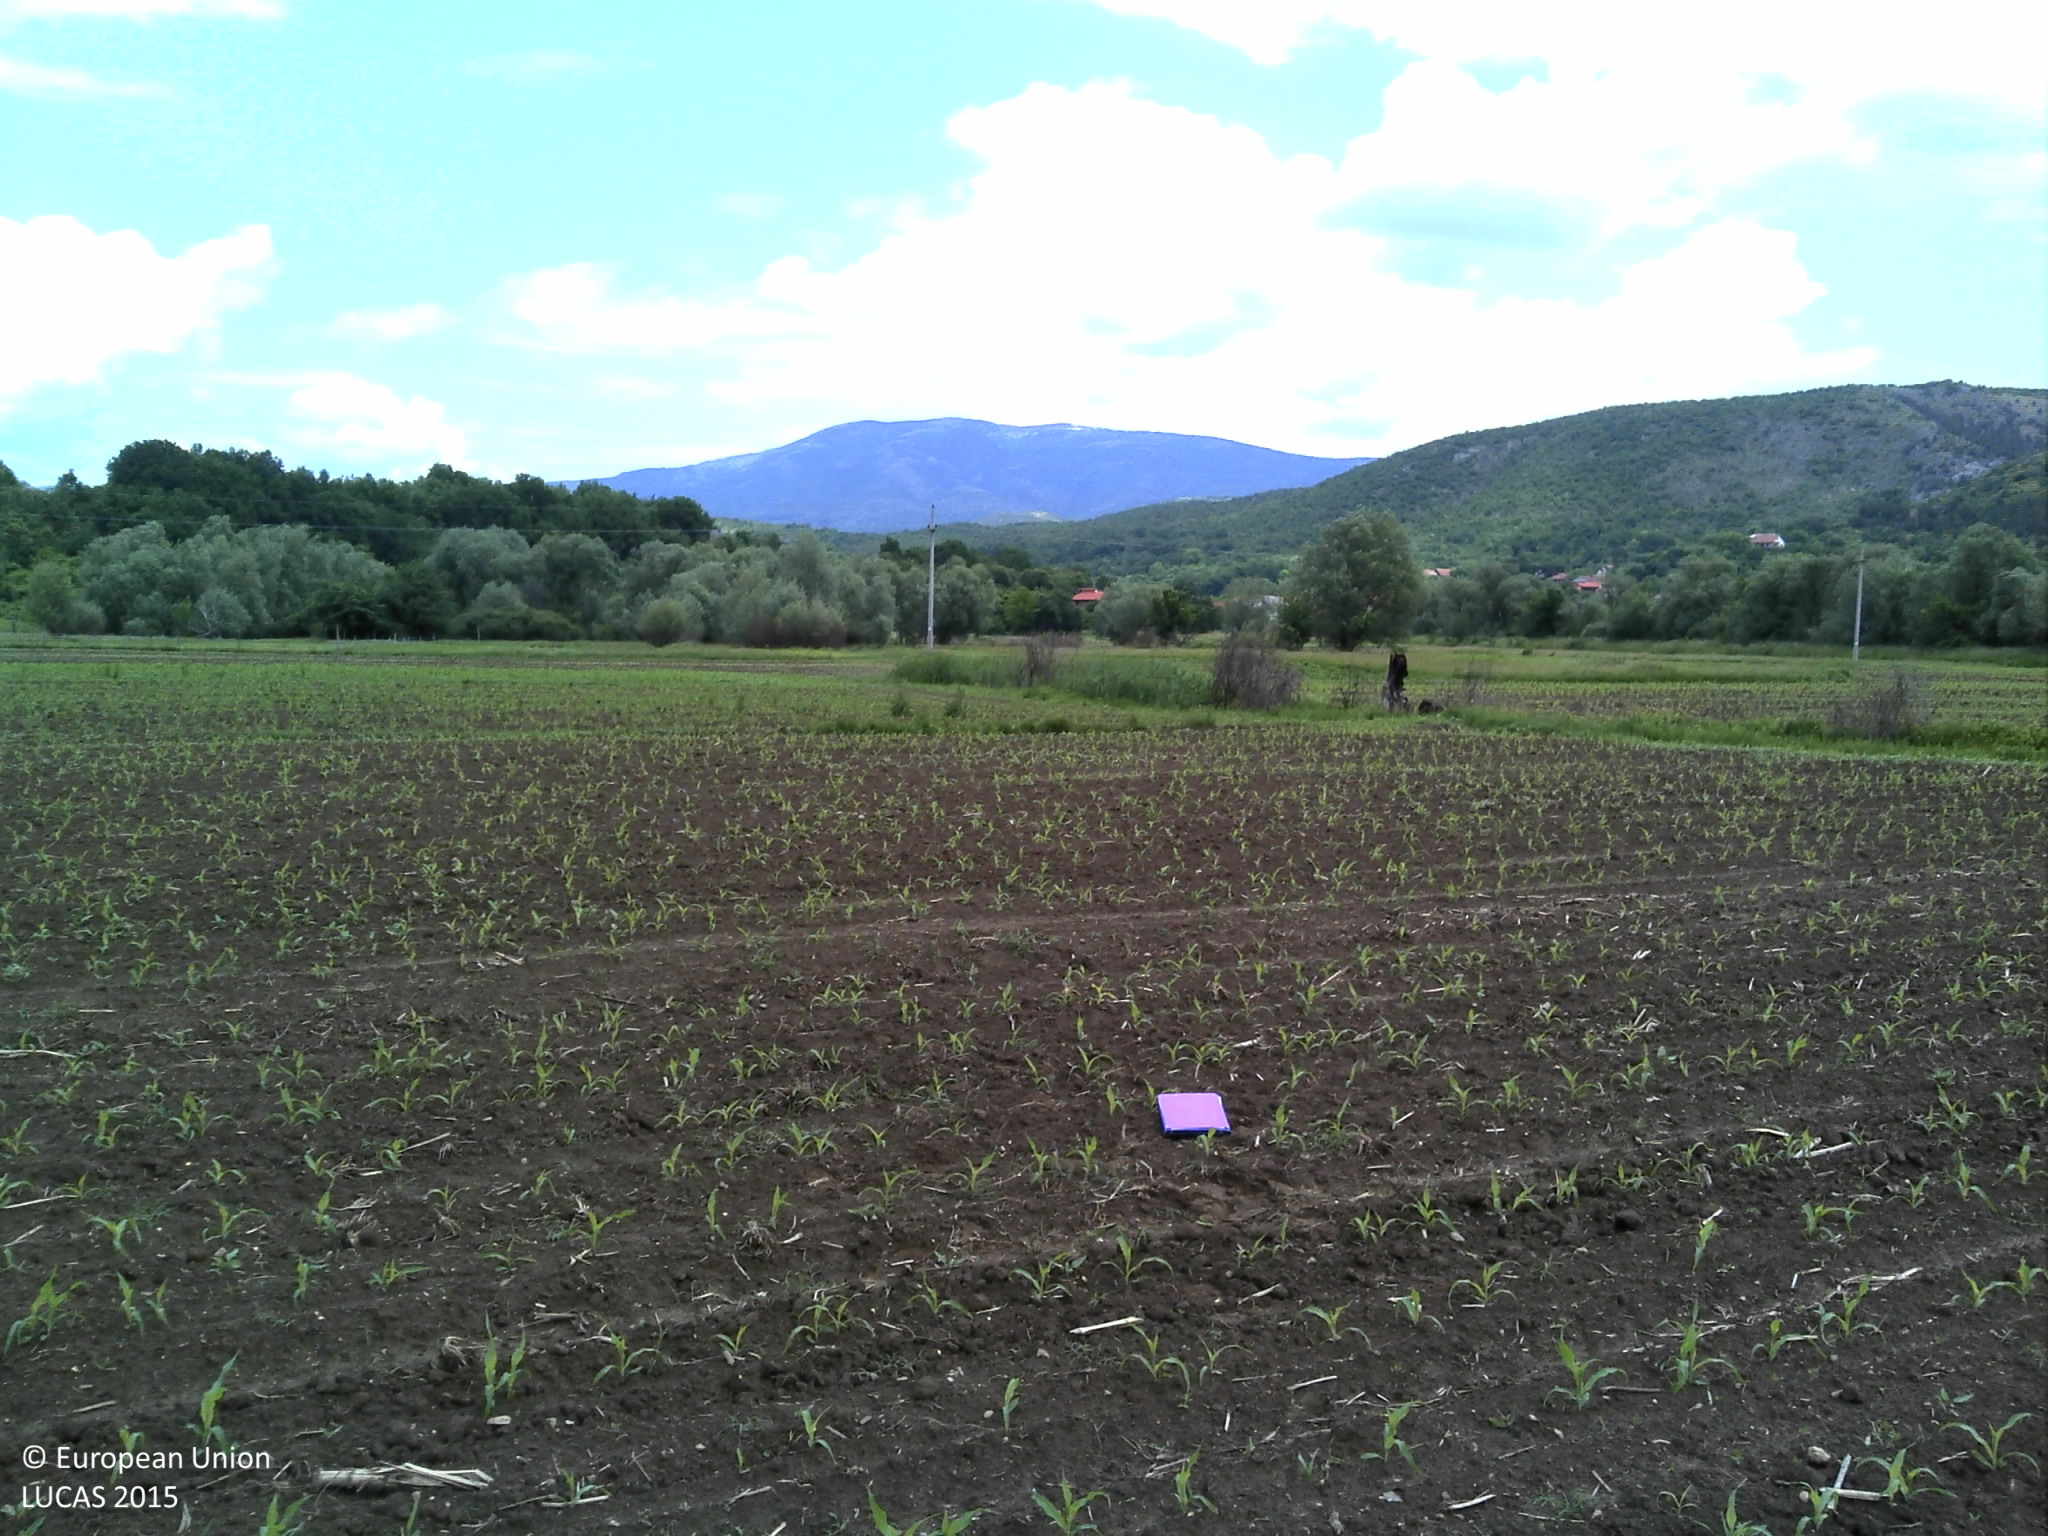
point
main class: Cropland
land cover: Maize
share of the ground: < 10 %
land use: Agriculture (excluding fallow land and kitchen gardens)
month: May
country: HR
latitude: 44.0374
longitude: 16.2194
